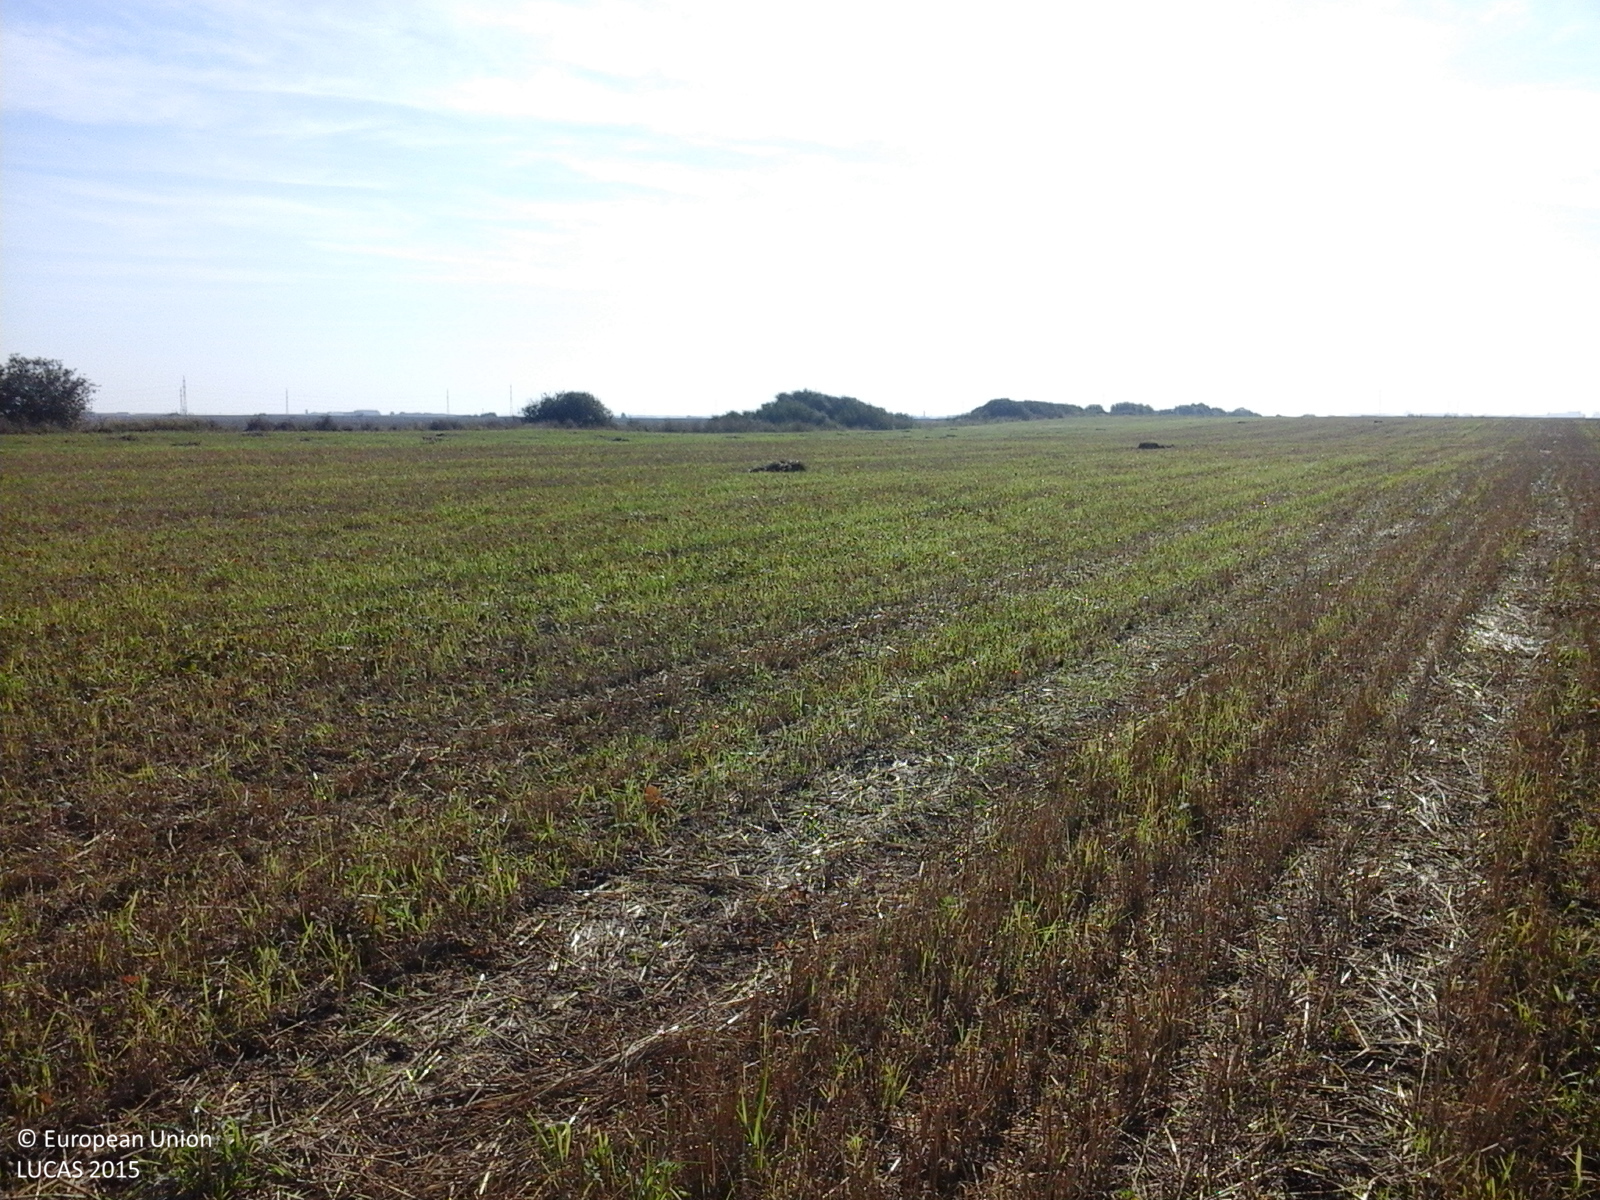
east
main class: Cropland
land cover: Durum wheat
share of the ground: 25 - 50 %
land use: Agriculture (excluding fallow land and kitchen gardens)
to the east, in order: Durum wheat; Abandoned hedges; Ditches and canals; Common wheat
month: August
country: RO
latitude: 45.7865
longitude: 21.1305
